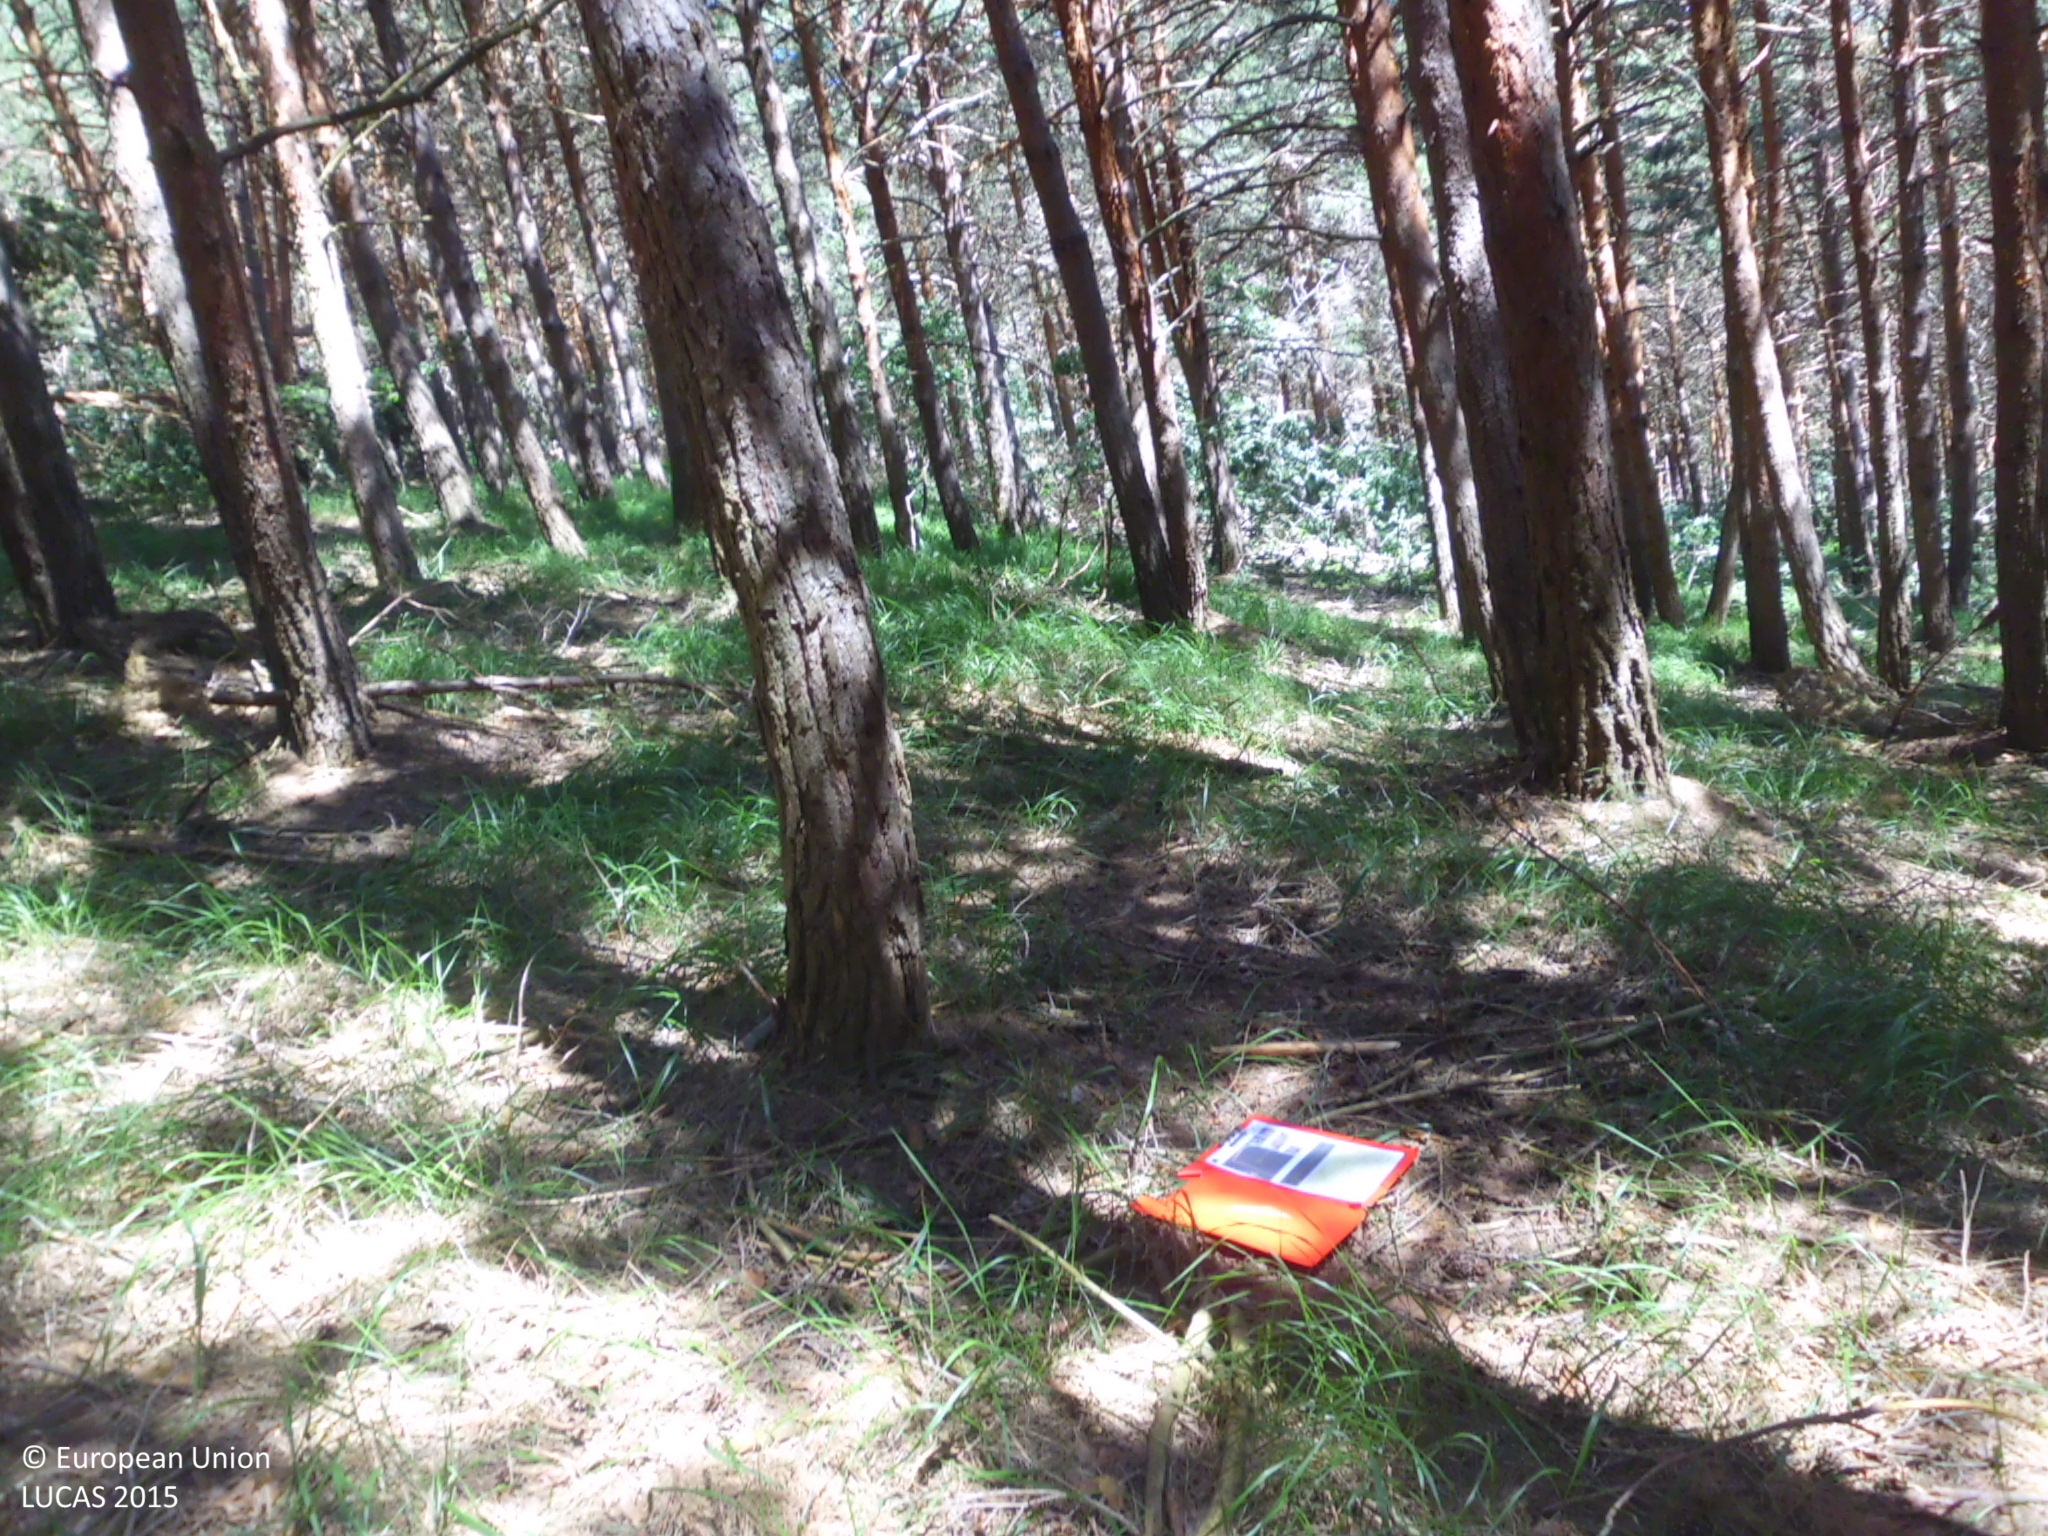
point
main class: Woodland
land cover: Pine dominated coniferous woodland
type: coniferous forest of the mediterranean region
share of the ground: > 75 %
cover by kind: coniferous forest trees 100 %
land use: Forestry
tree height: > 5 m
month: July
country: ES
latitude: 42.8328
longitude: -4.1043
